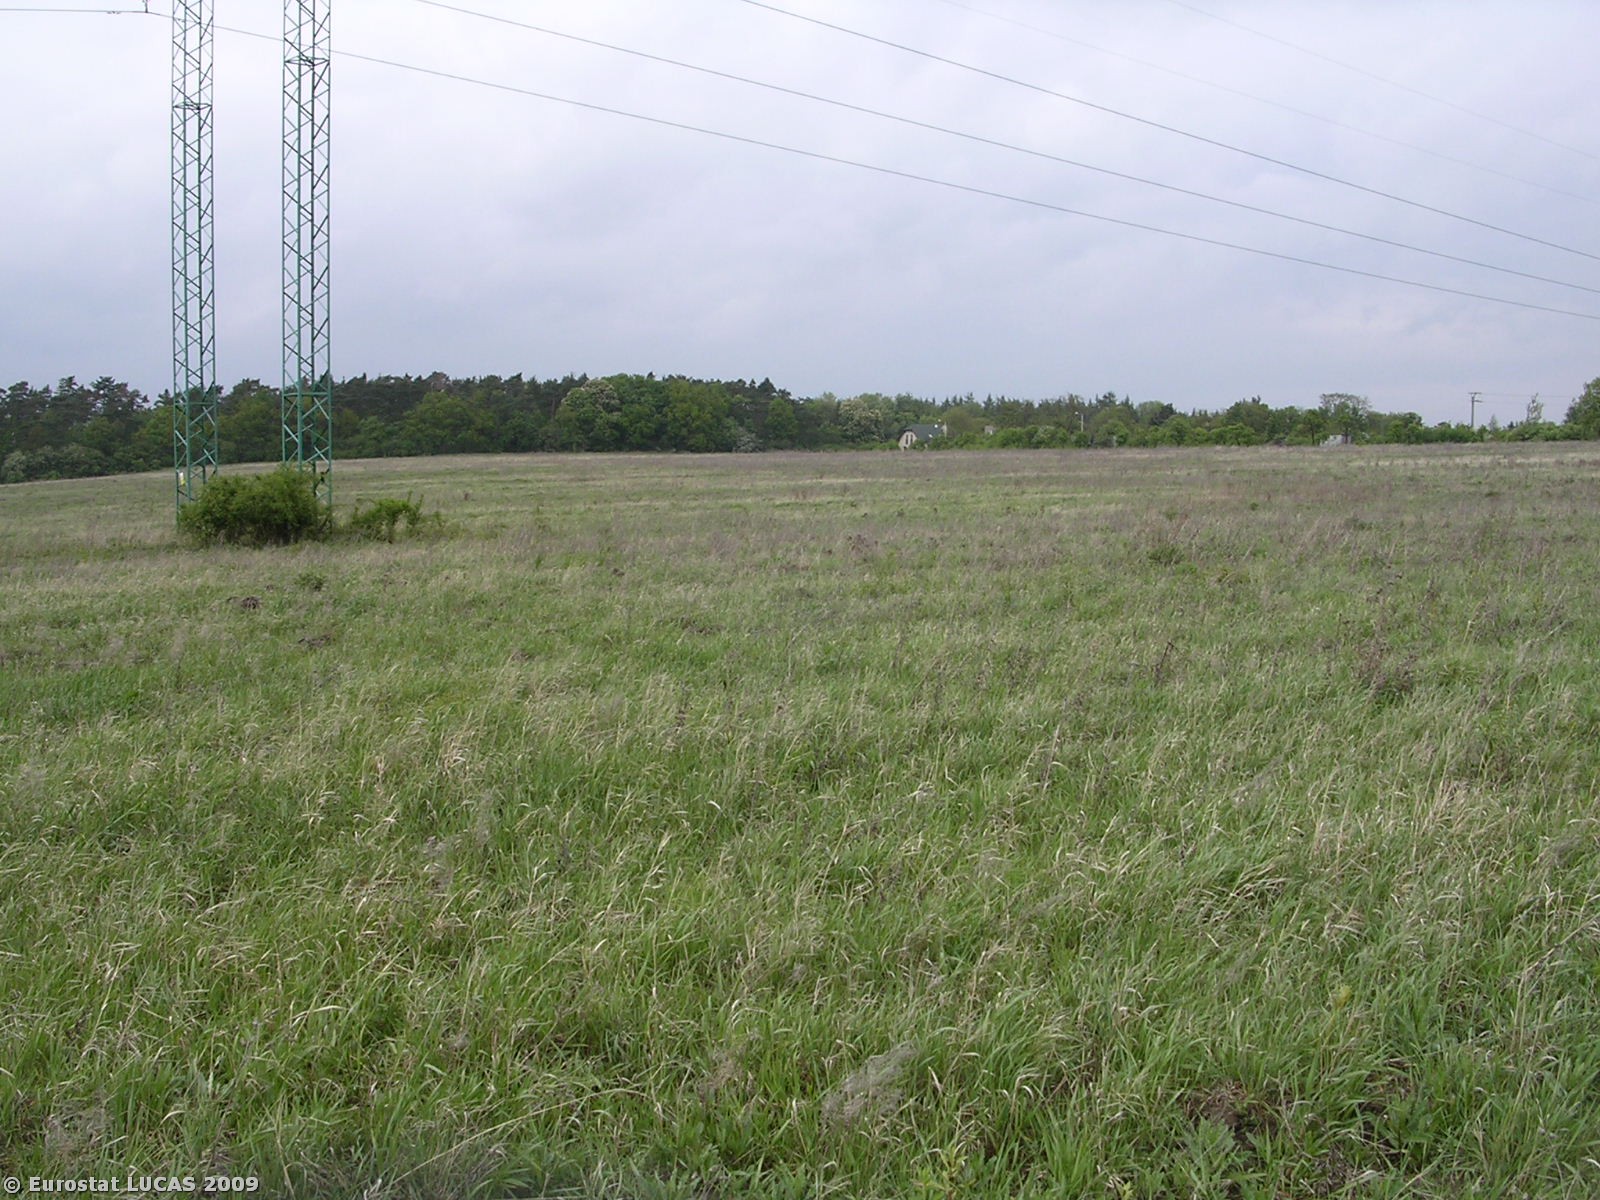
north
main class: Grassland
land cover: Grassland without tree/shrub cover
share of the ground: > 75 %
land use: Fallow land
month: May
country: CZ
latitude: 50.0556
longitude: 14.5971
